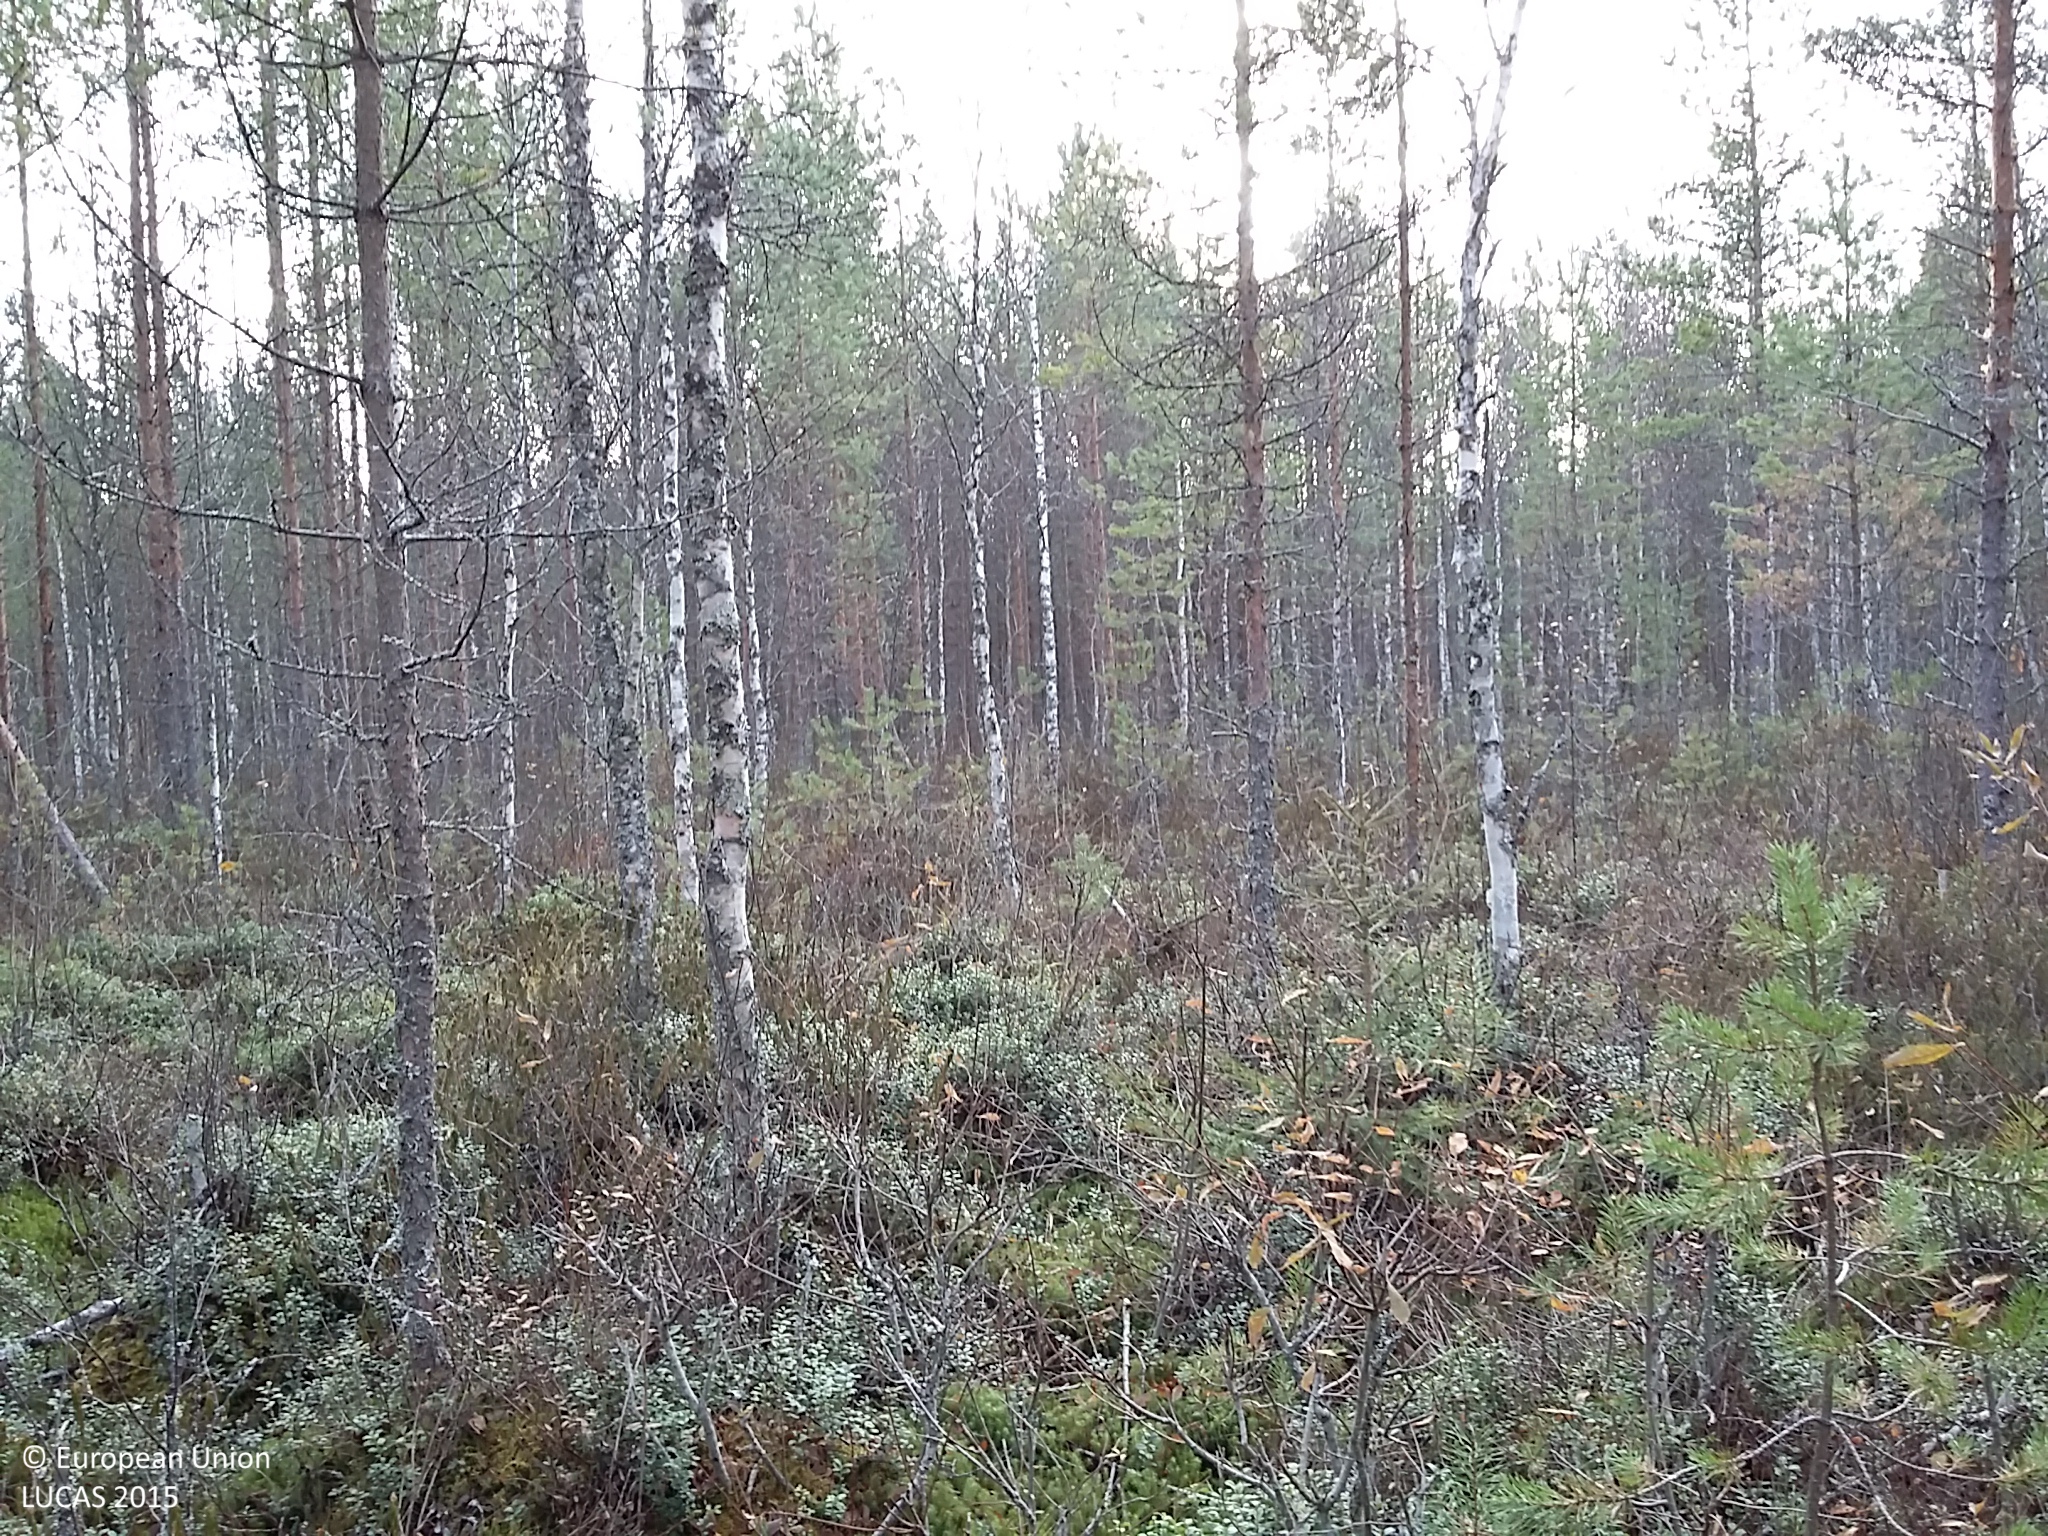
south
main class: Woodland
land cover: Pine dominated mixed woodland
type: boreal forest
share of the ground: > 75 %
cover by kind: coniferous forest trees 55 %, broadleaved forest trees 25 %, shrubs 10 %, herbaceous plants 5 %, lichens and mosses 5 %
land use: Forestry
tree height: > 5 m
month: October
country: FI
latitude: 64.6198
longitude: 25.5848
